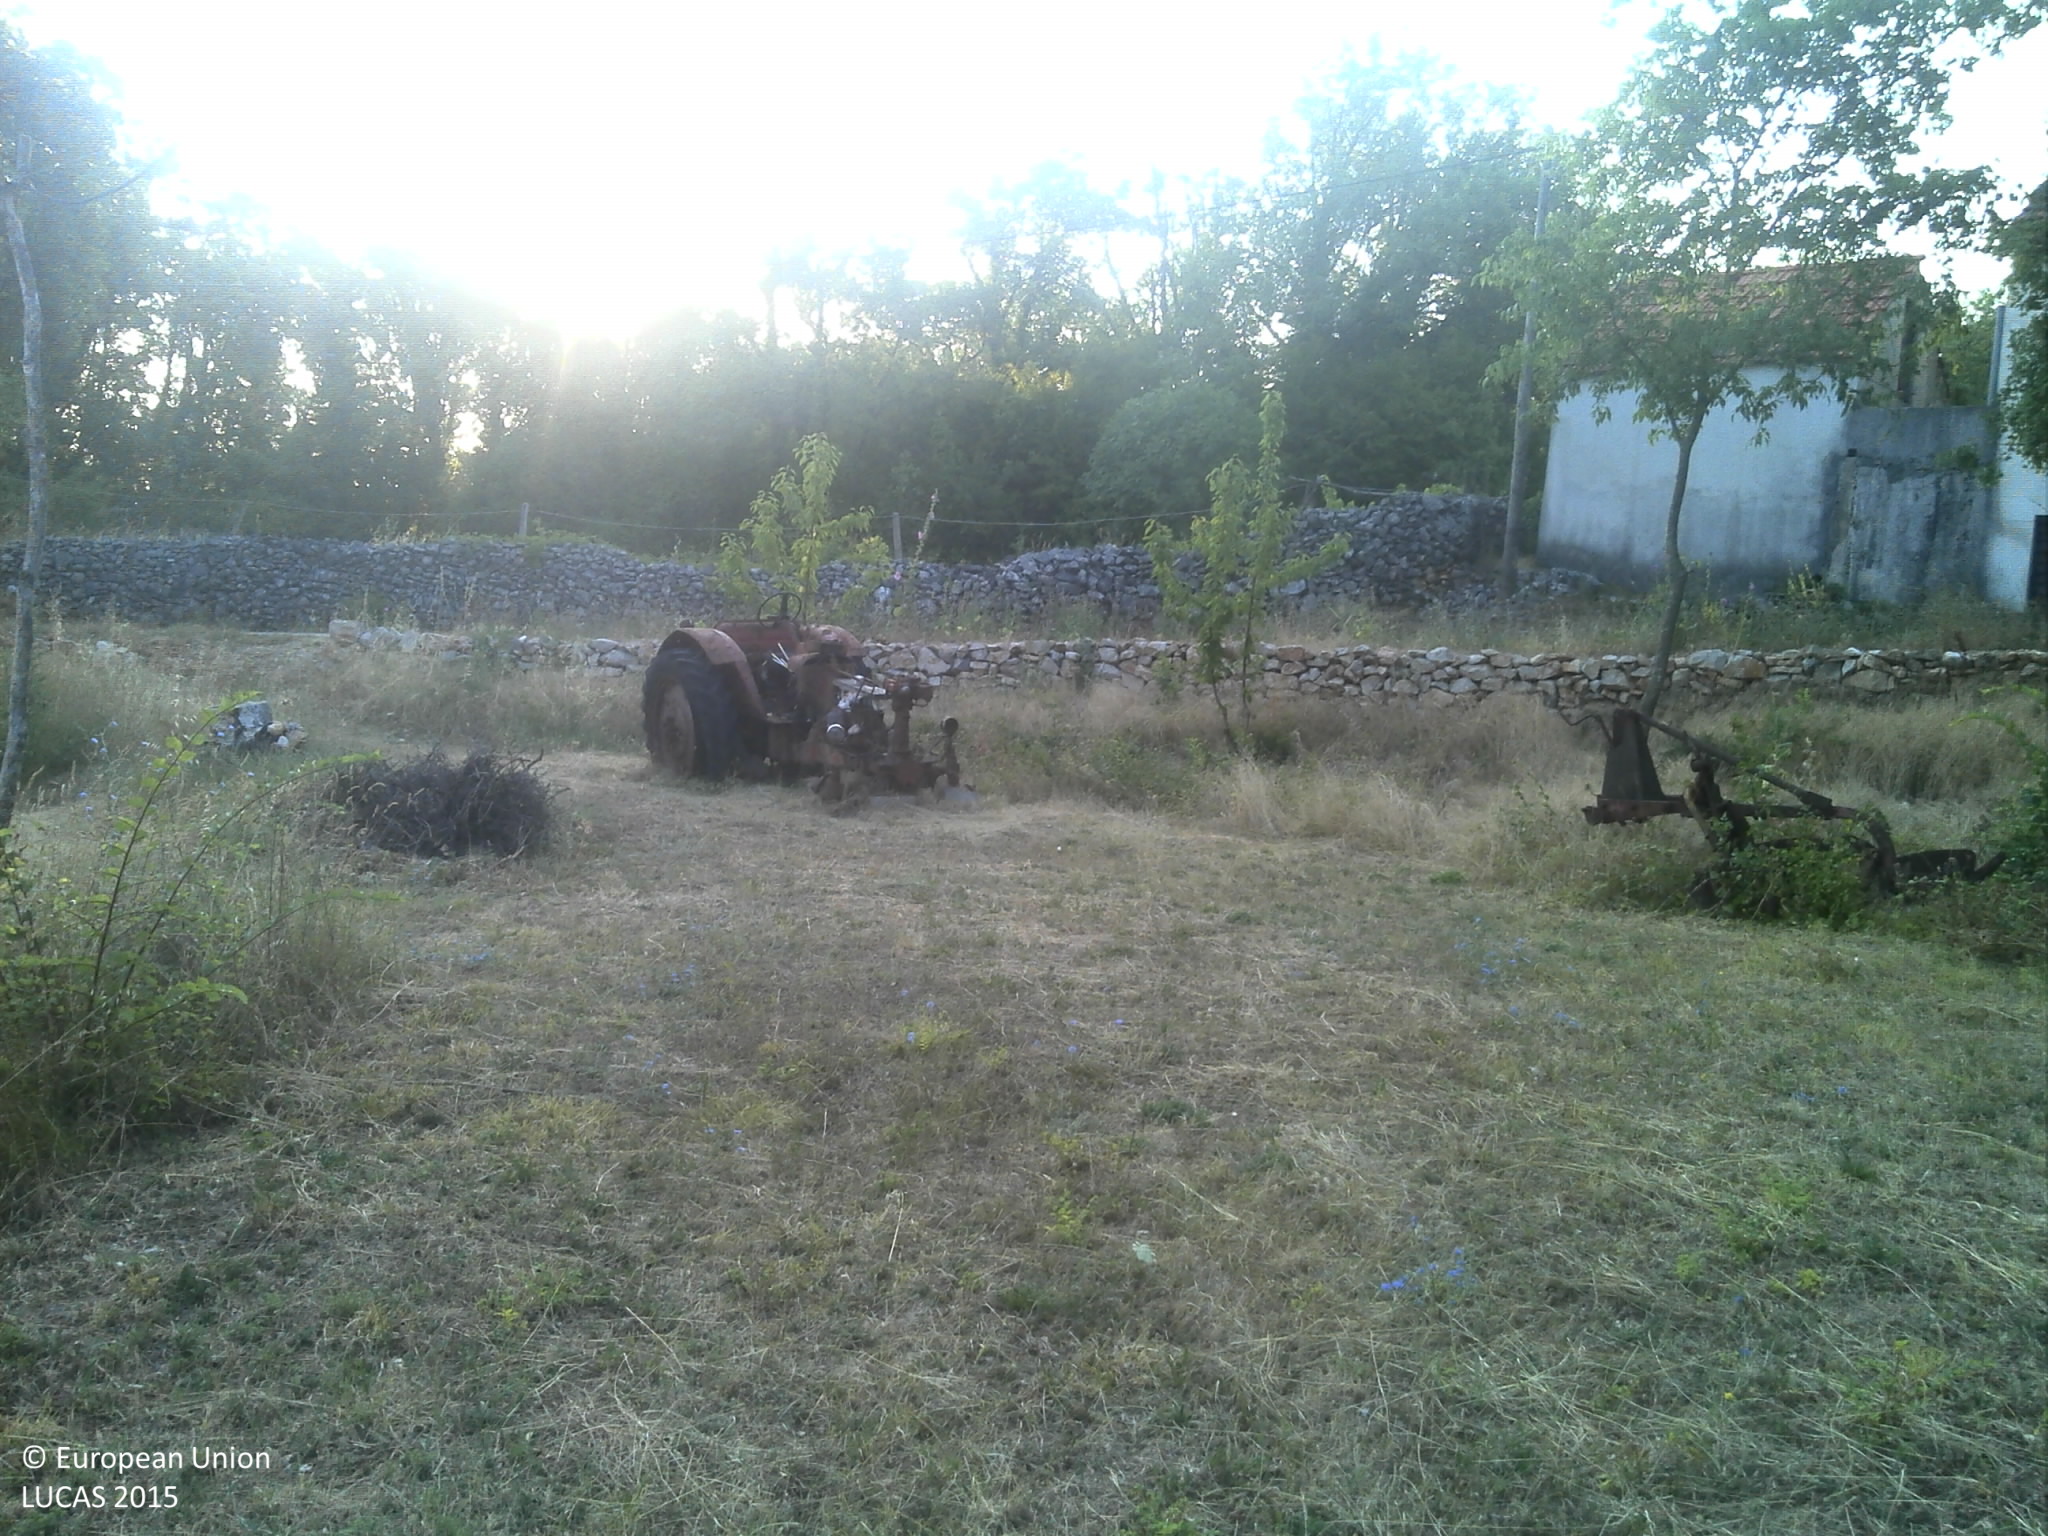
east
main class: Grassland
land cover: Grassland without tree/shrub cover
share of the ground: > 75 %
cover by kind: herbaceous plants 95 %, shrubs 5 %
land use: Agriculture (excluding fallow land and kitchen gardens)
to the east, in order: Grassland without tree/shrub cover; Shruby margins; Abandoned hedges; Paved roads, cycling and walking lanes; Broadleaved woodland; Dry stone walls; Shrubland with sparse tree cover; Dry stone walls; Broadleaved woodland; Dry stone walls; Broadleaved woodland
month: July
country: HR
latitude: 43.4145
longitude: 17.1671
